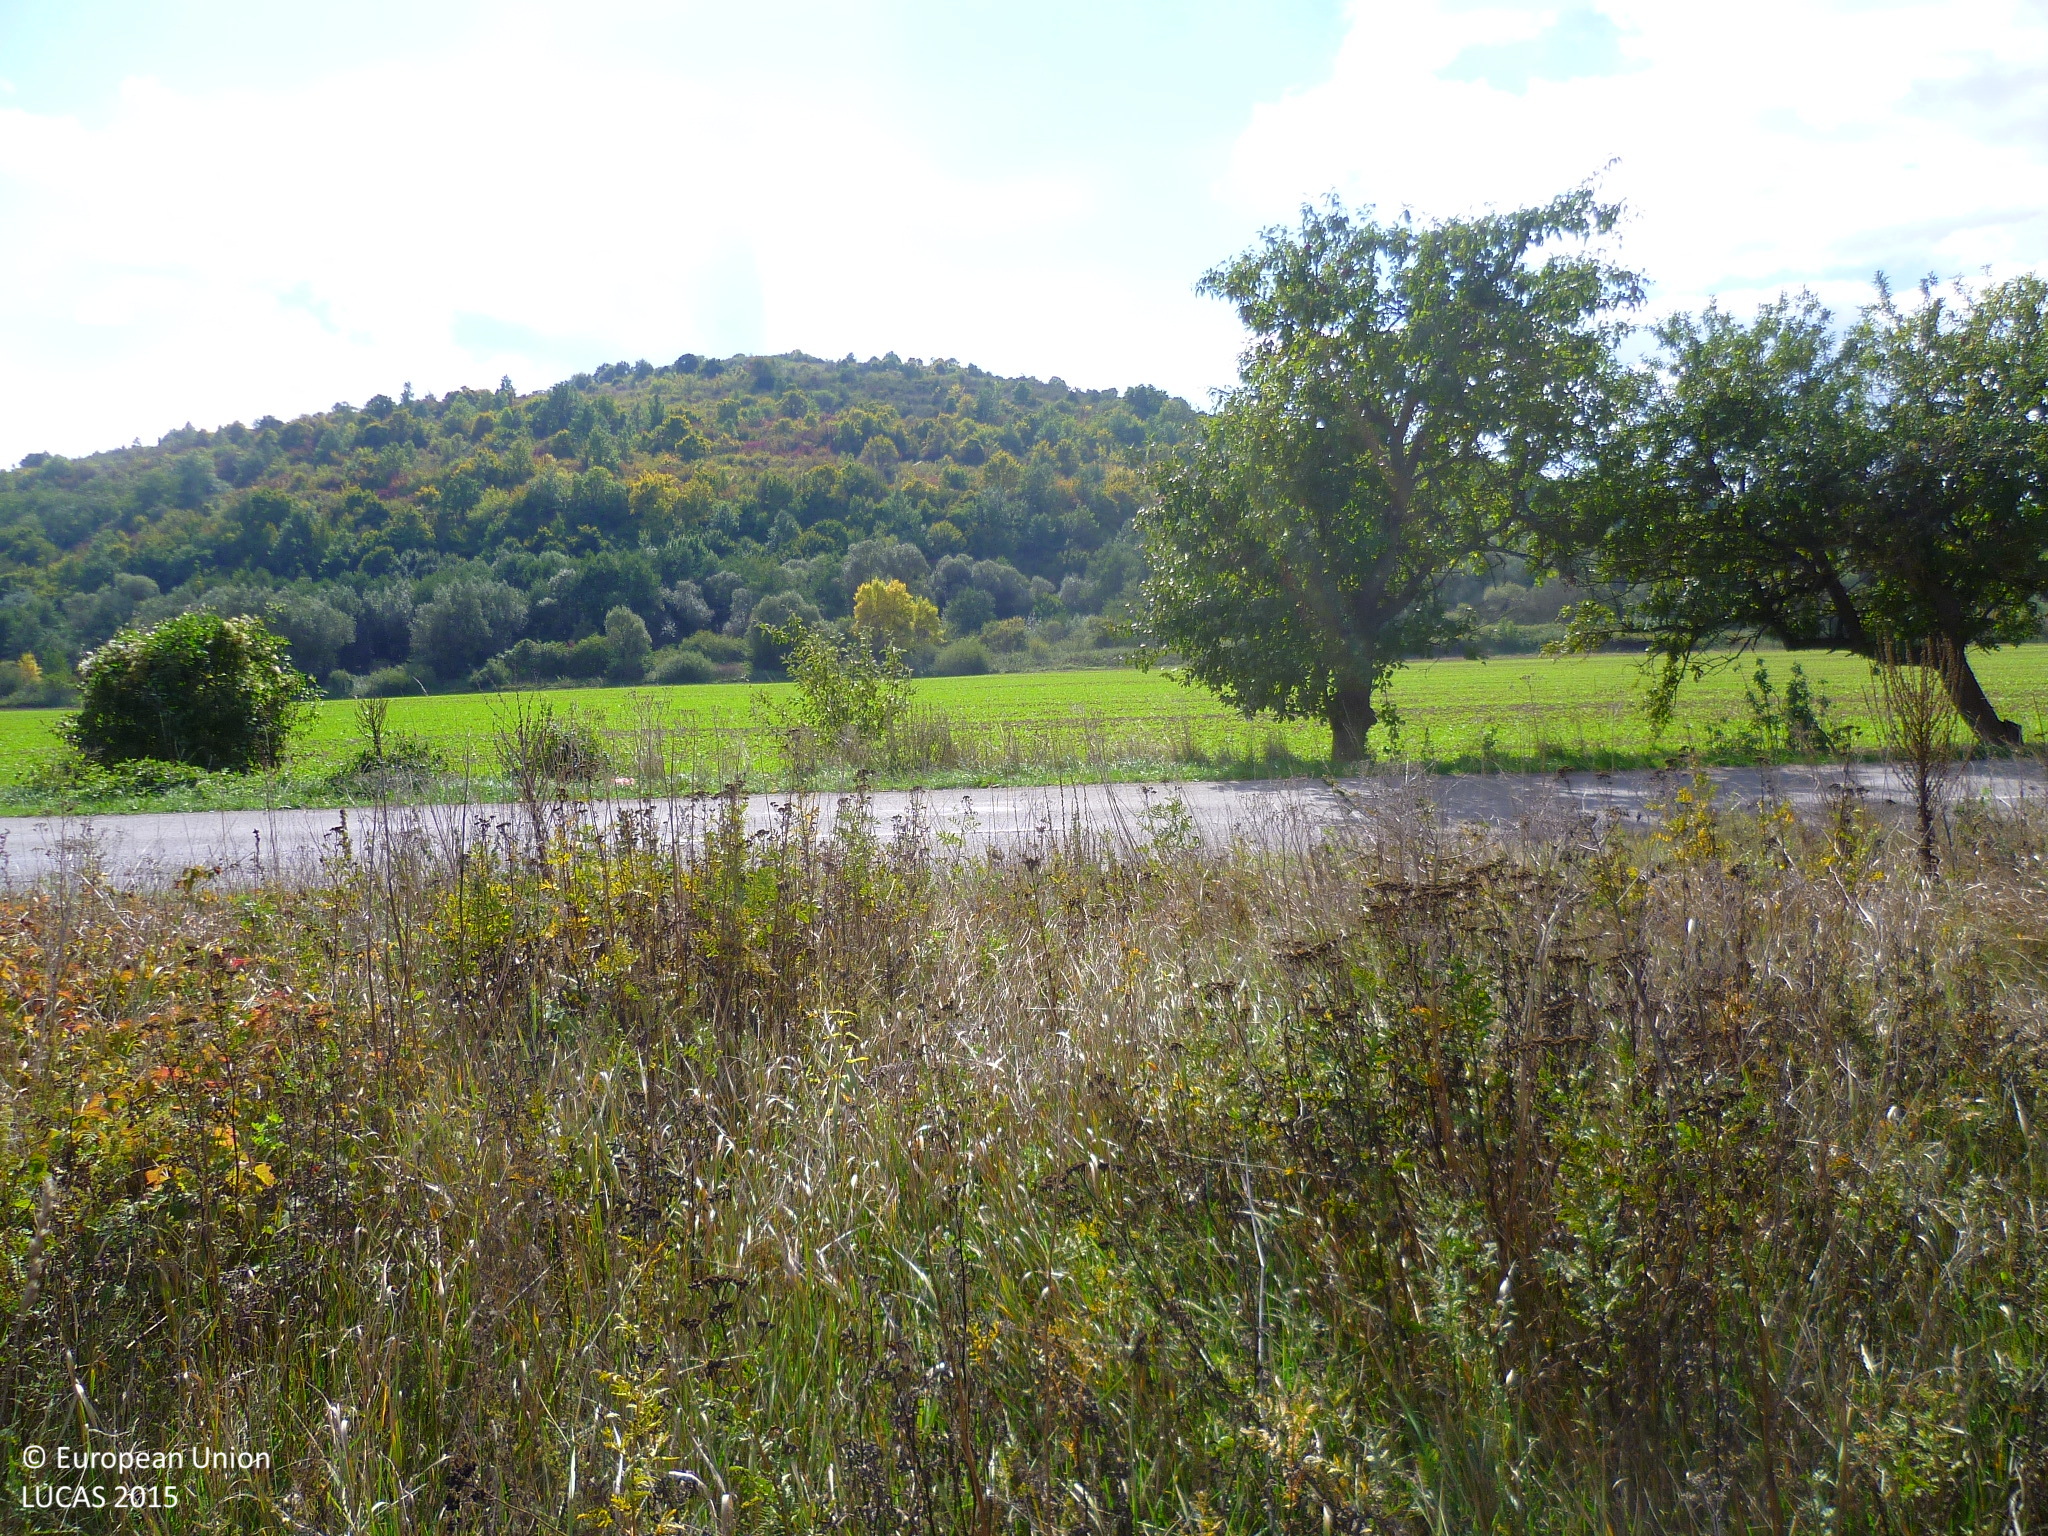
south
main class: Grassland
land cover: Grassland without tree/shrub cover
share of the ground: > 75 %
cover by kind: herbaceous plants 100 %
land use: Agriculture (excluding fallow land and kitchen gardens)
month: October
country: BG
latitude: 42.8207
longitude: 22.5374
